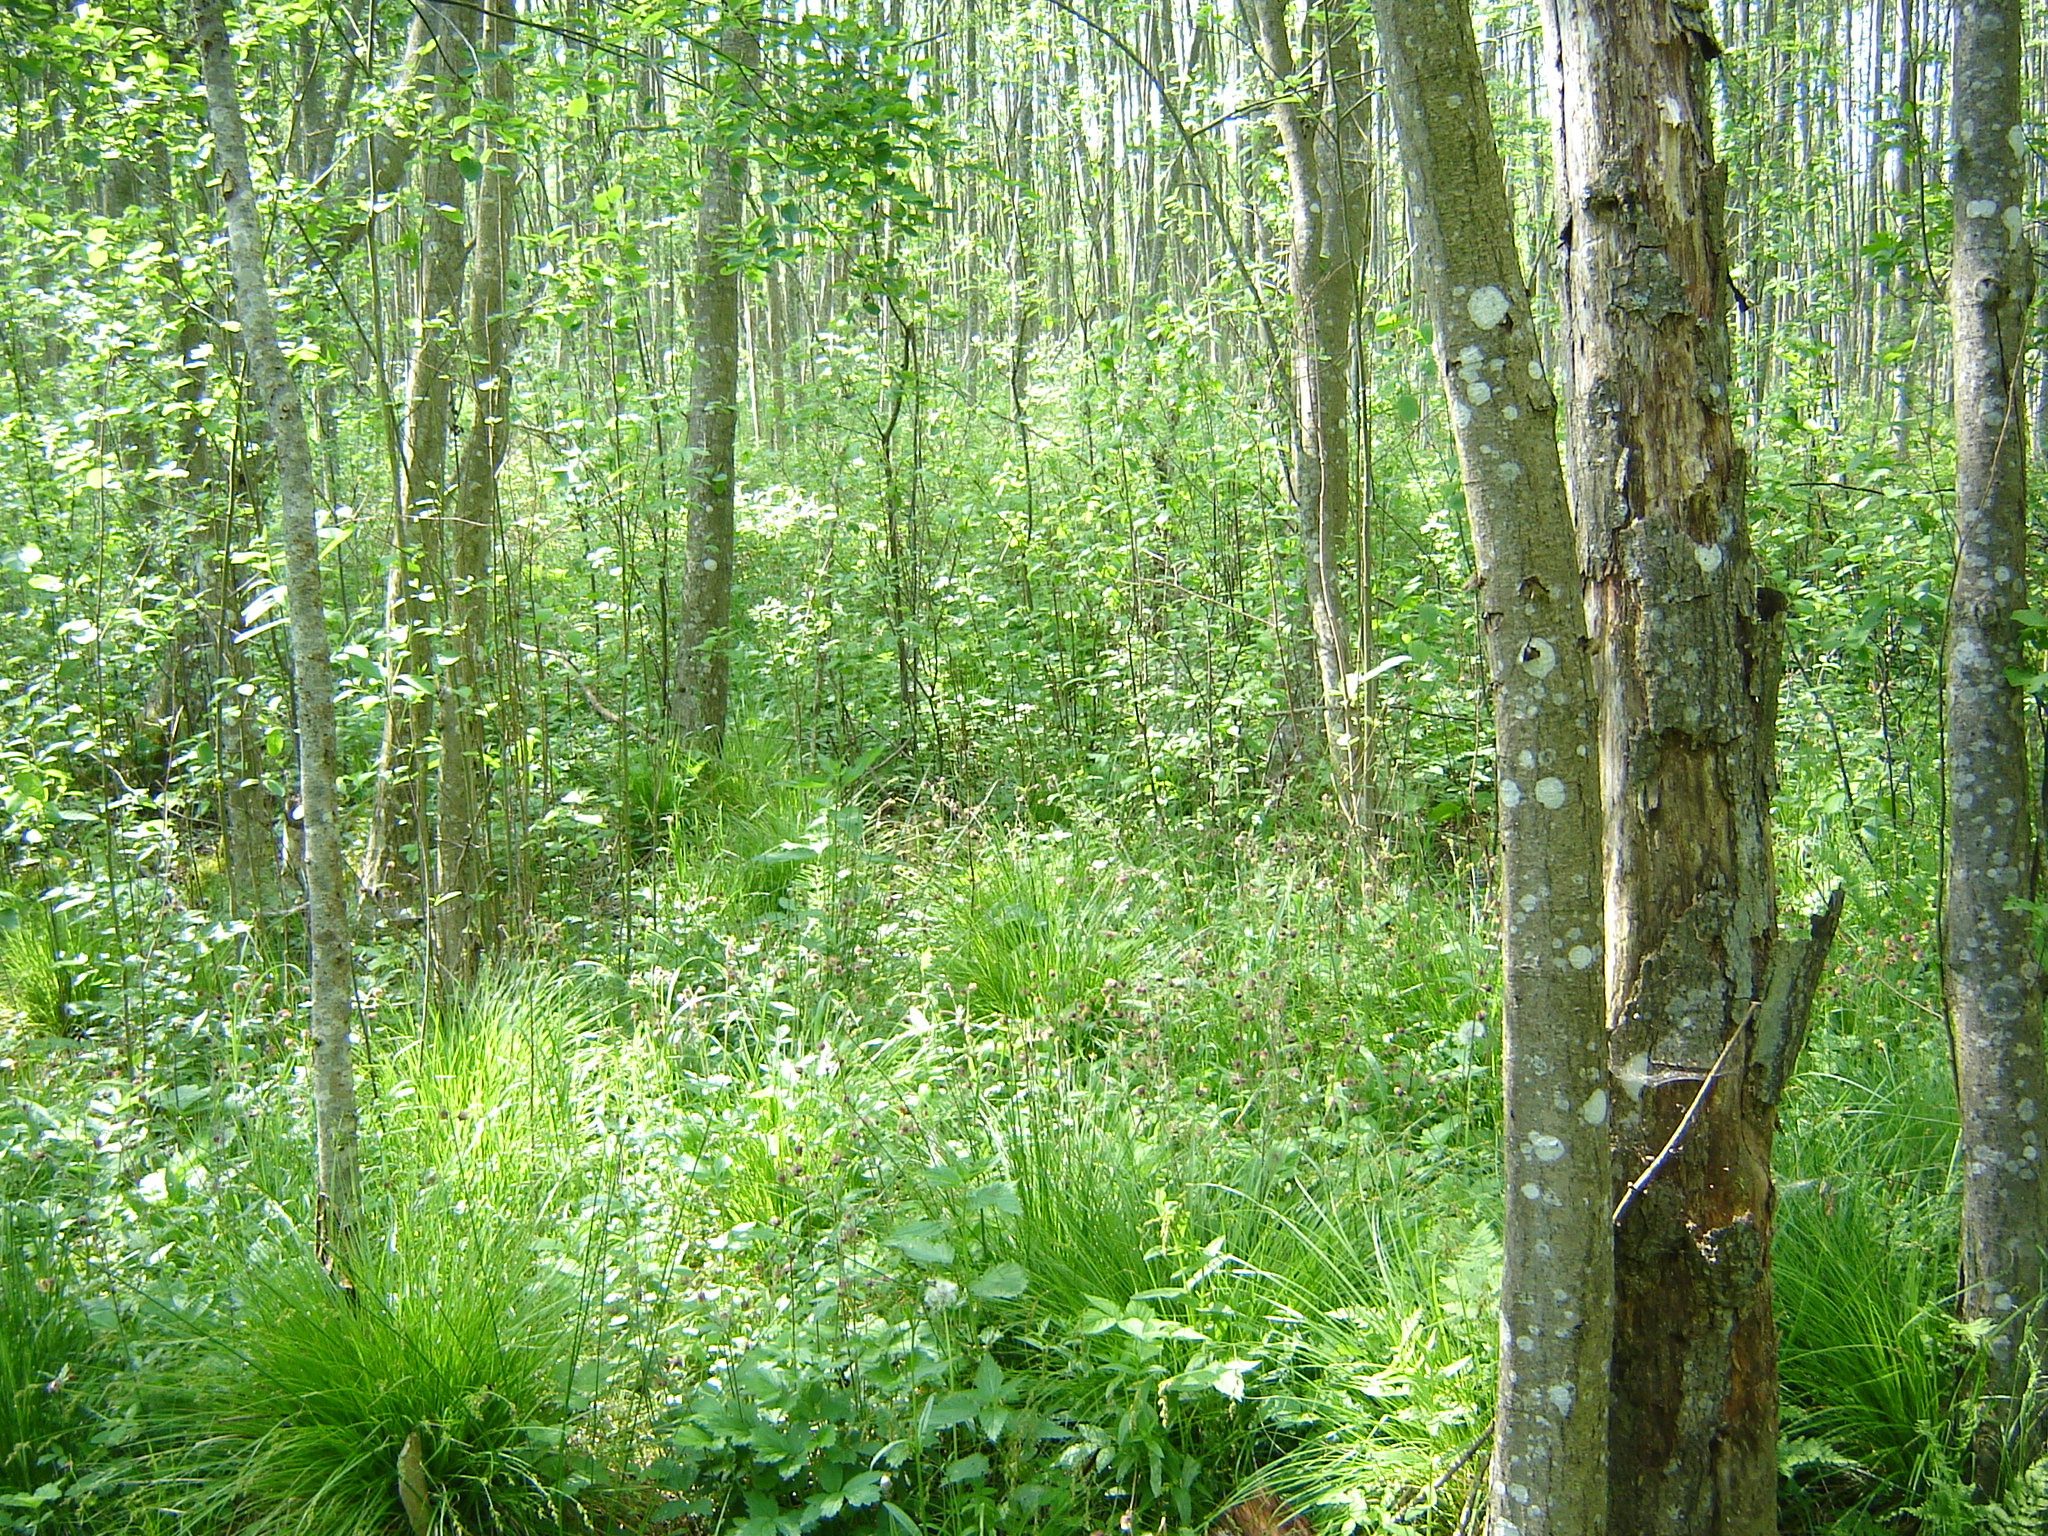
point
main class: Woodland
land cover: Broadleaved woodland
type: floodplain forest
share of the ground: > 75 %
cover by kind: broadleaved forest trees 90 %, herbaceous plants 10 %
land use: Forestry
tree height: > 5 m
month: June
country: LT
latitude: 55.9220
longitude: 25.3041
